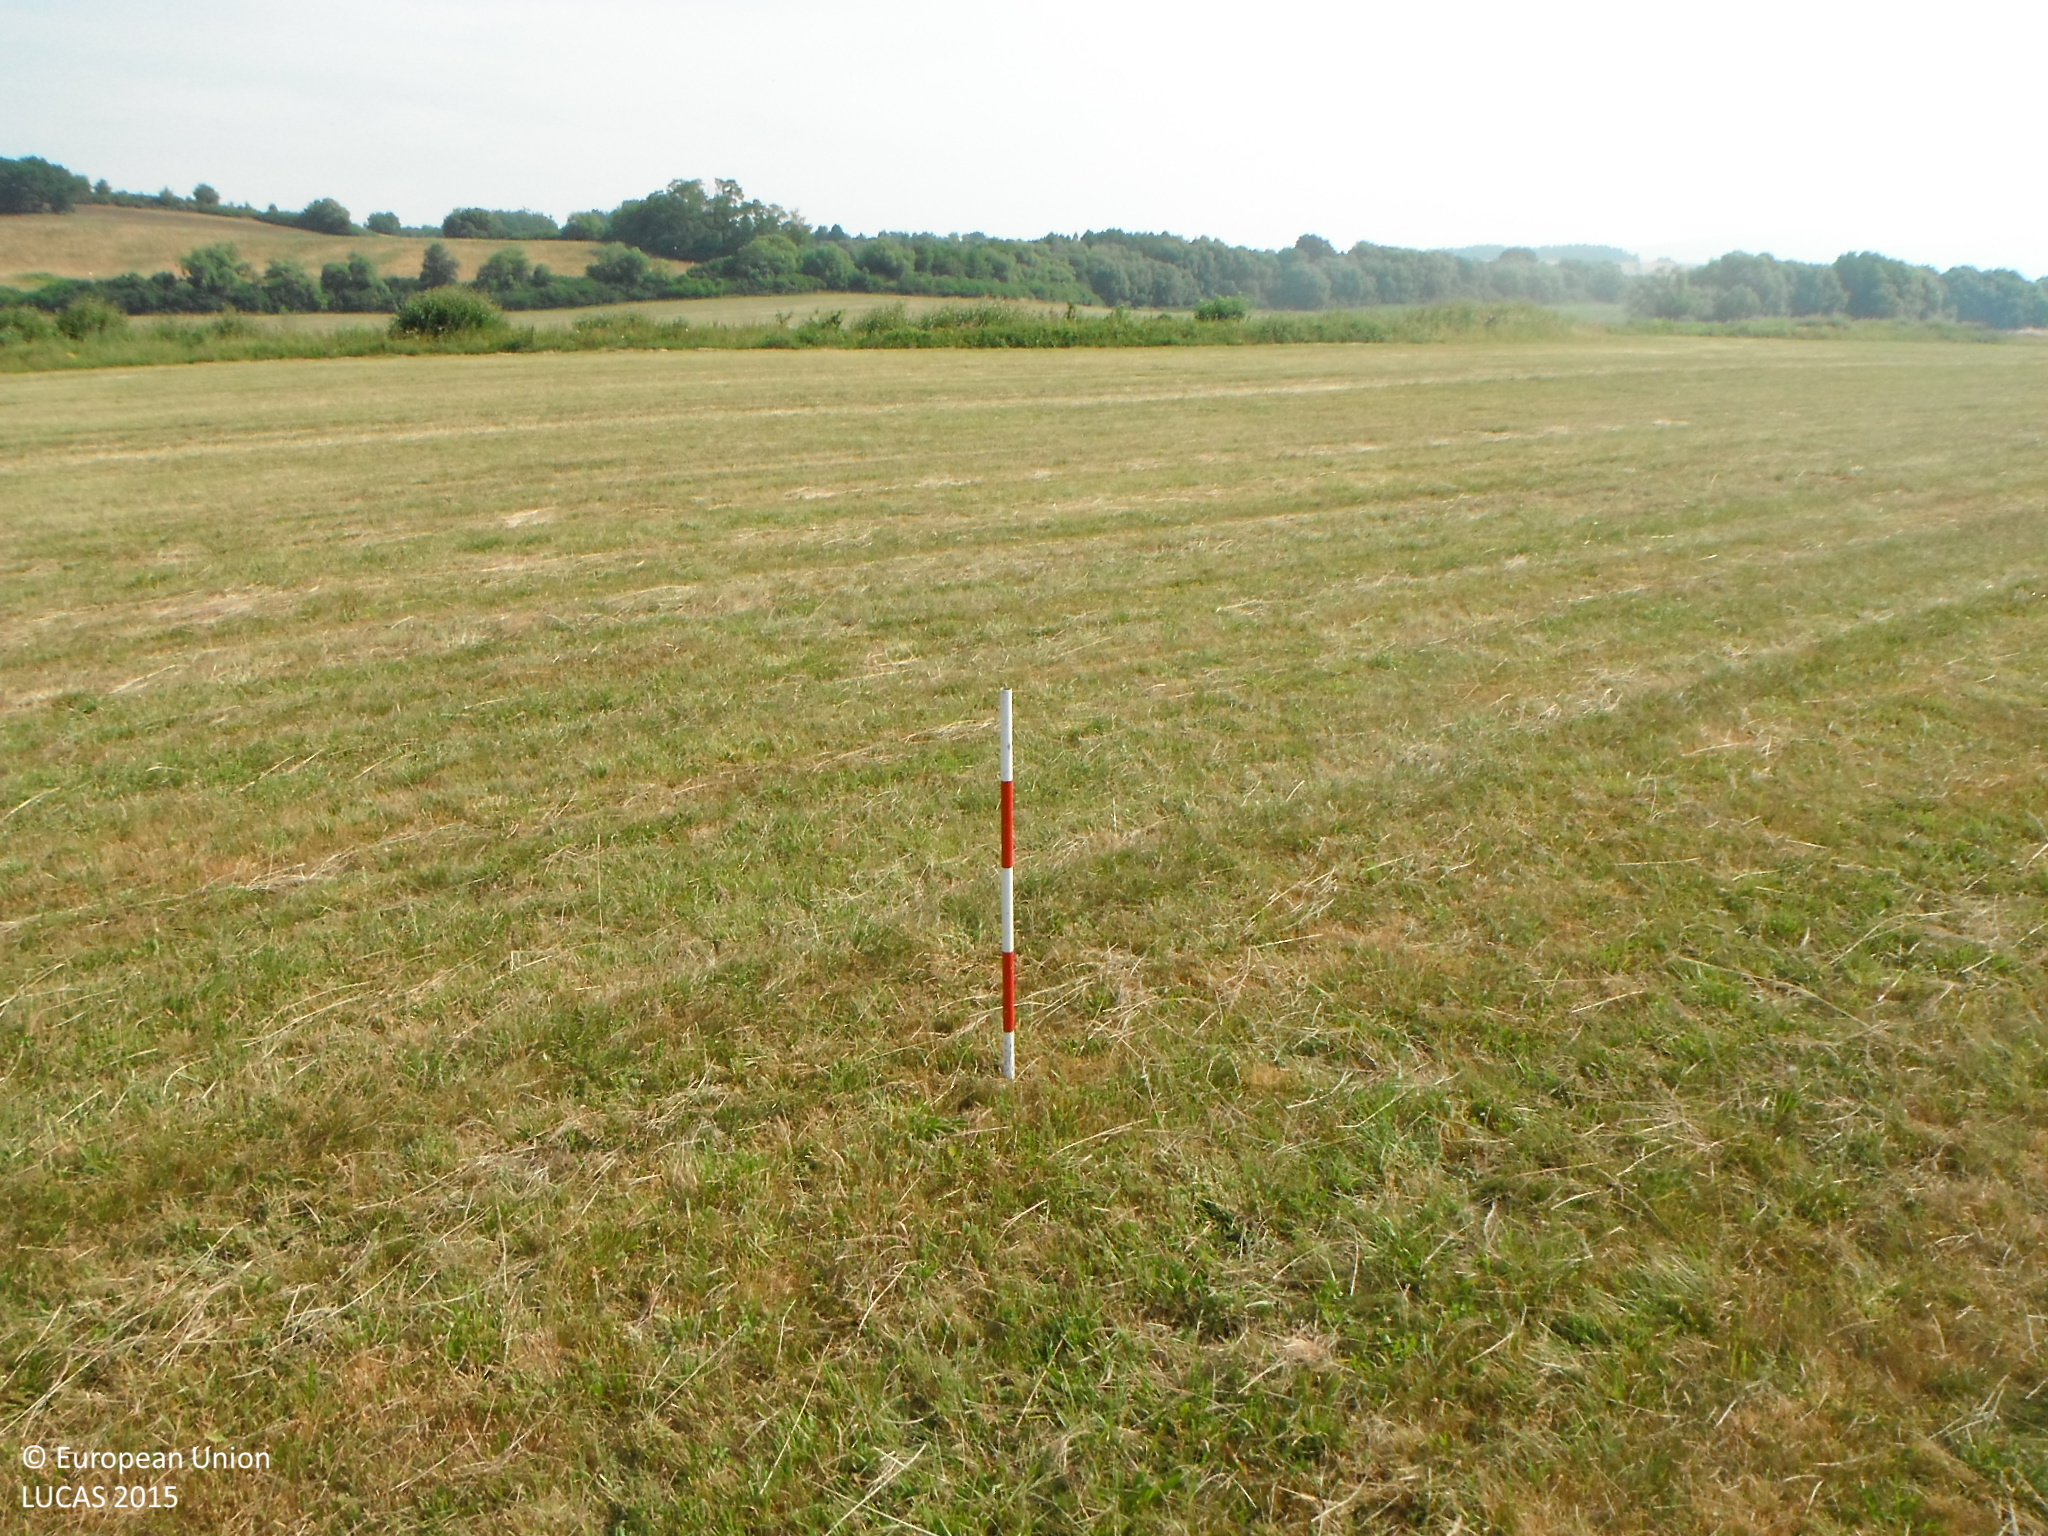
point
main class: Grassland
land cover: Grassland without tree/shrub cover
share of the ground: > 75 %
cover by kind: herbaceous plants 100 %
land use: Agriculture (excluding fallow land and kitchen gardens)
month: July
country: SK
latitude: 48.5940
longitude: 19.2565
